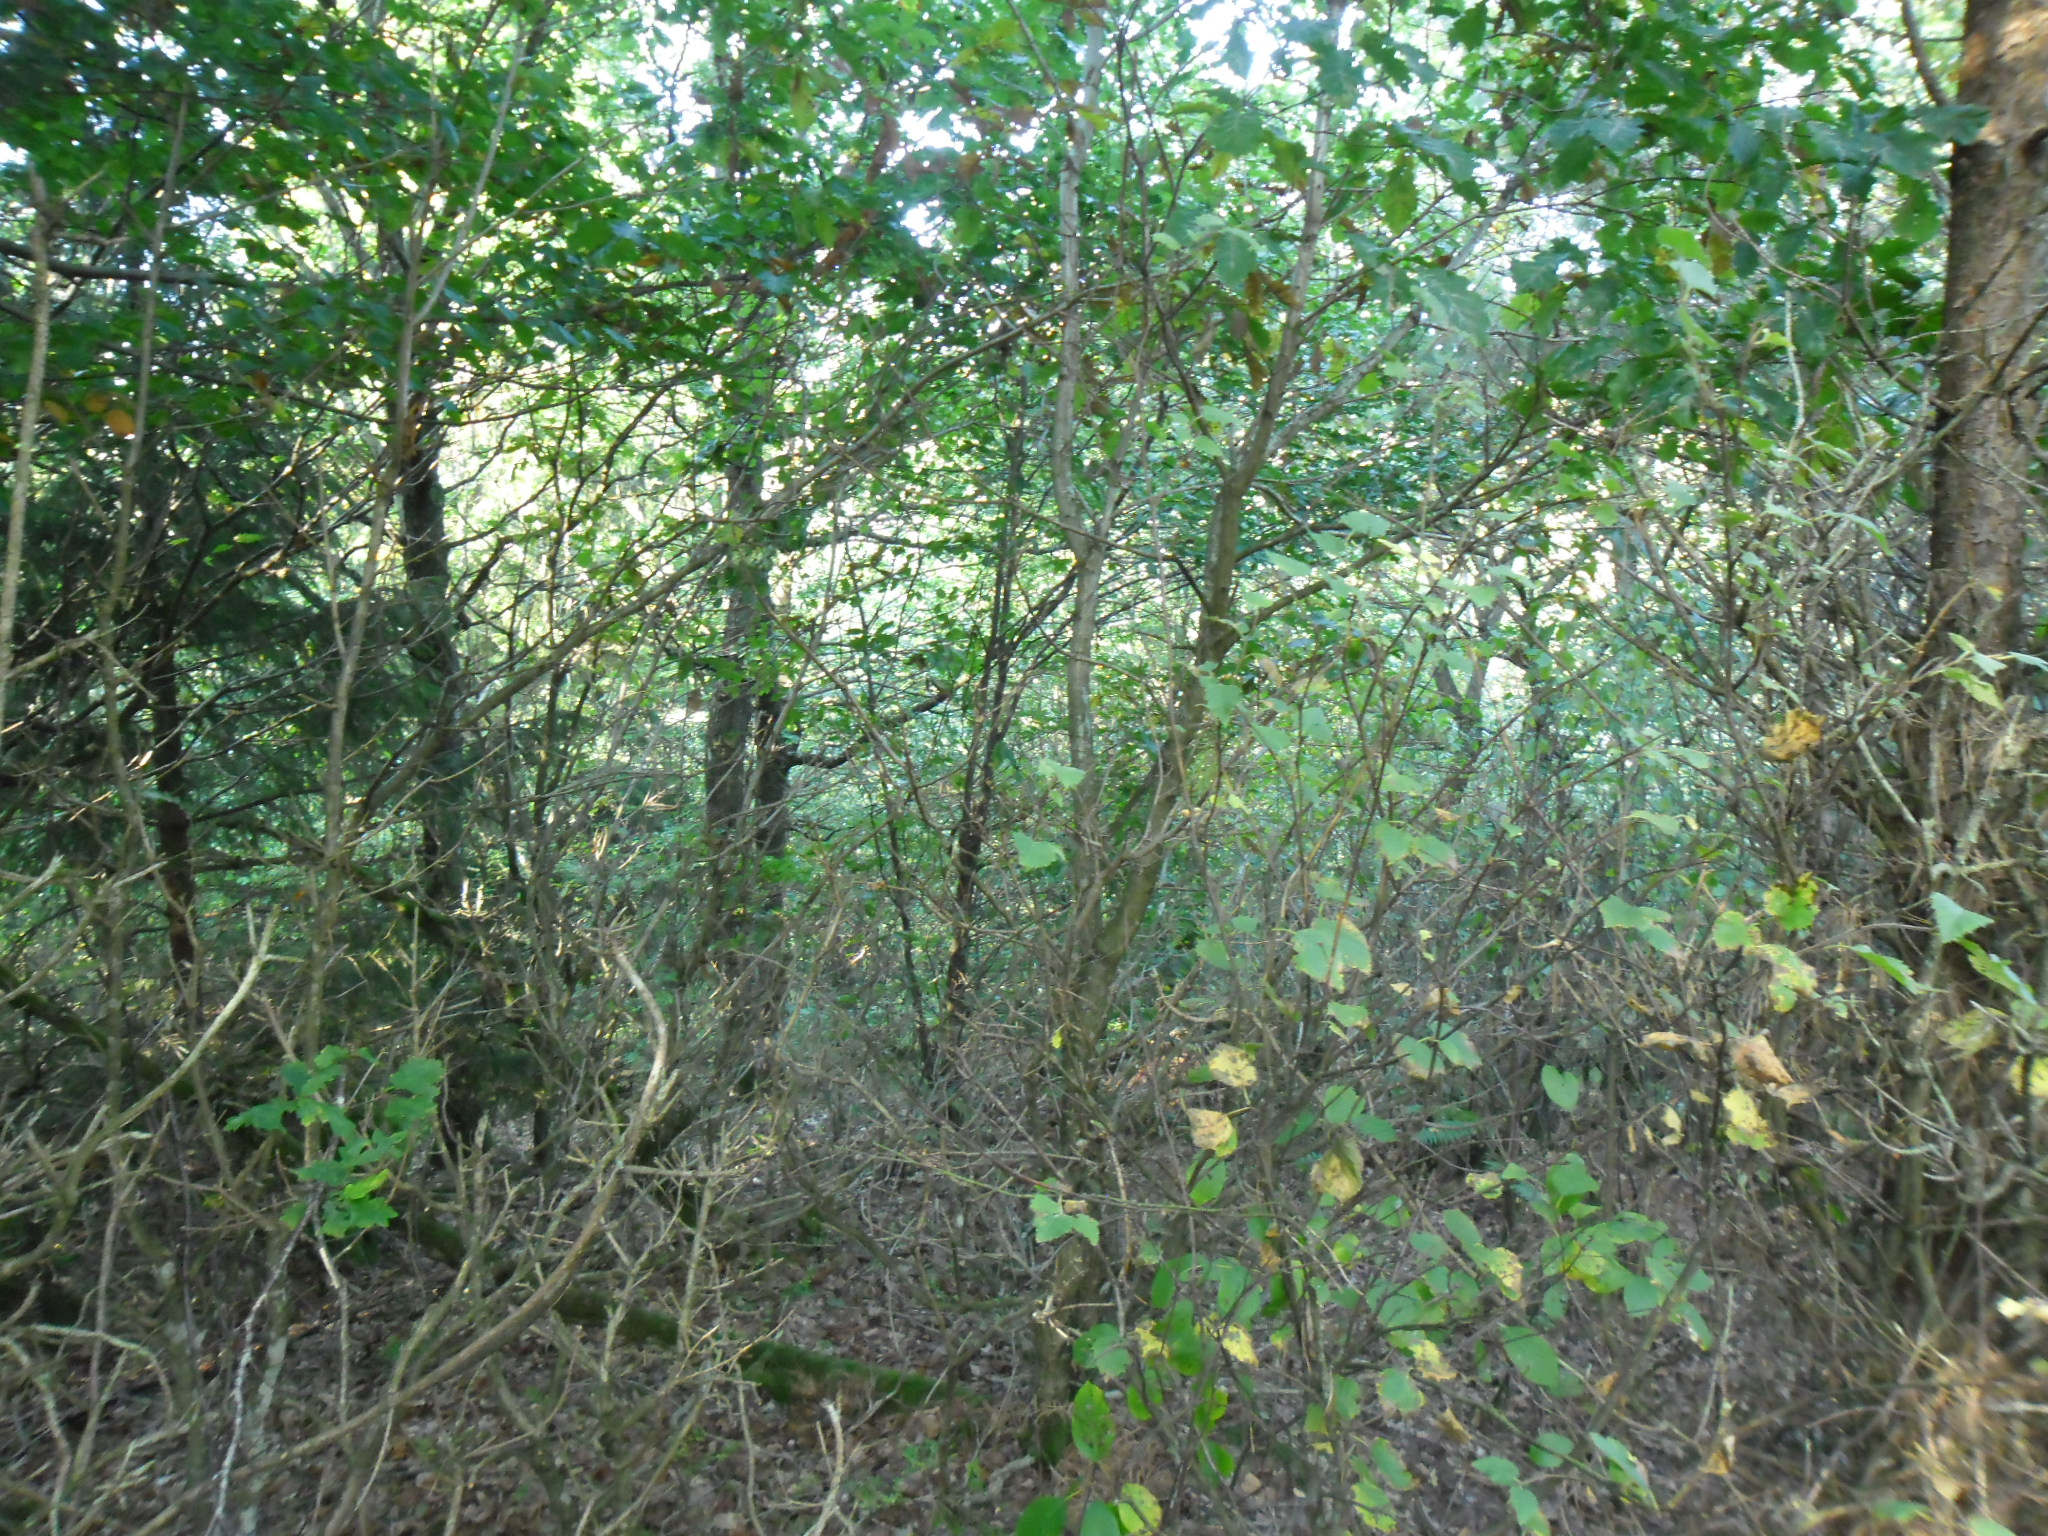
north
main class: Woodland
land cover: Other mixed woodland
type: acidophilous oak and oak-birch forest
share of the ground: > 75 %
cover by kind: broadleaved forest trees 50 %, coniferous forest trees 30 %, shrubs 10 %, unconsolidated bare surface 10 %
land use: Semi-natural and natural areas not in use
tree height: > 5 m
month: October
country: SE
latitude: 56.5984
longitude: 13.1730
